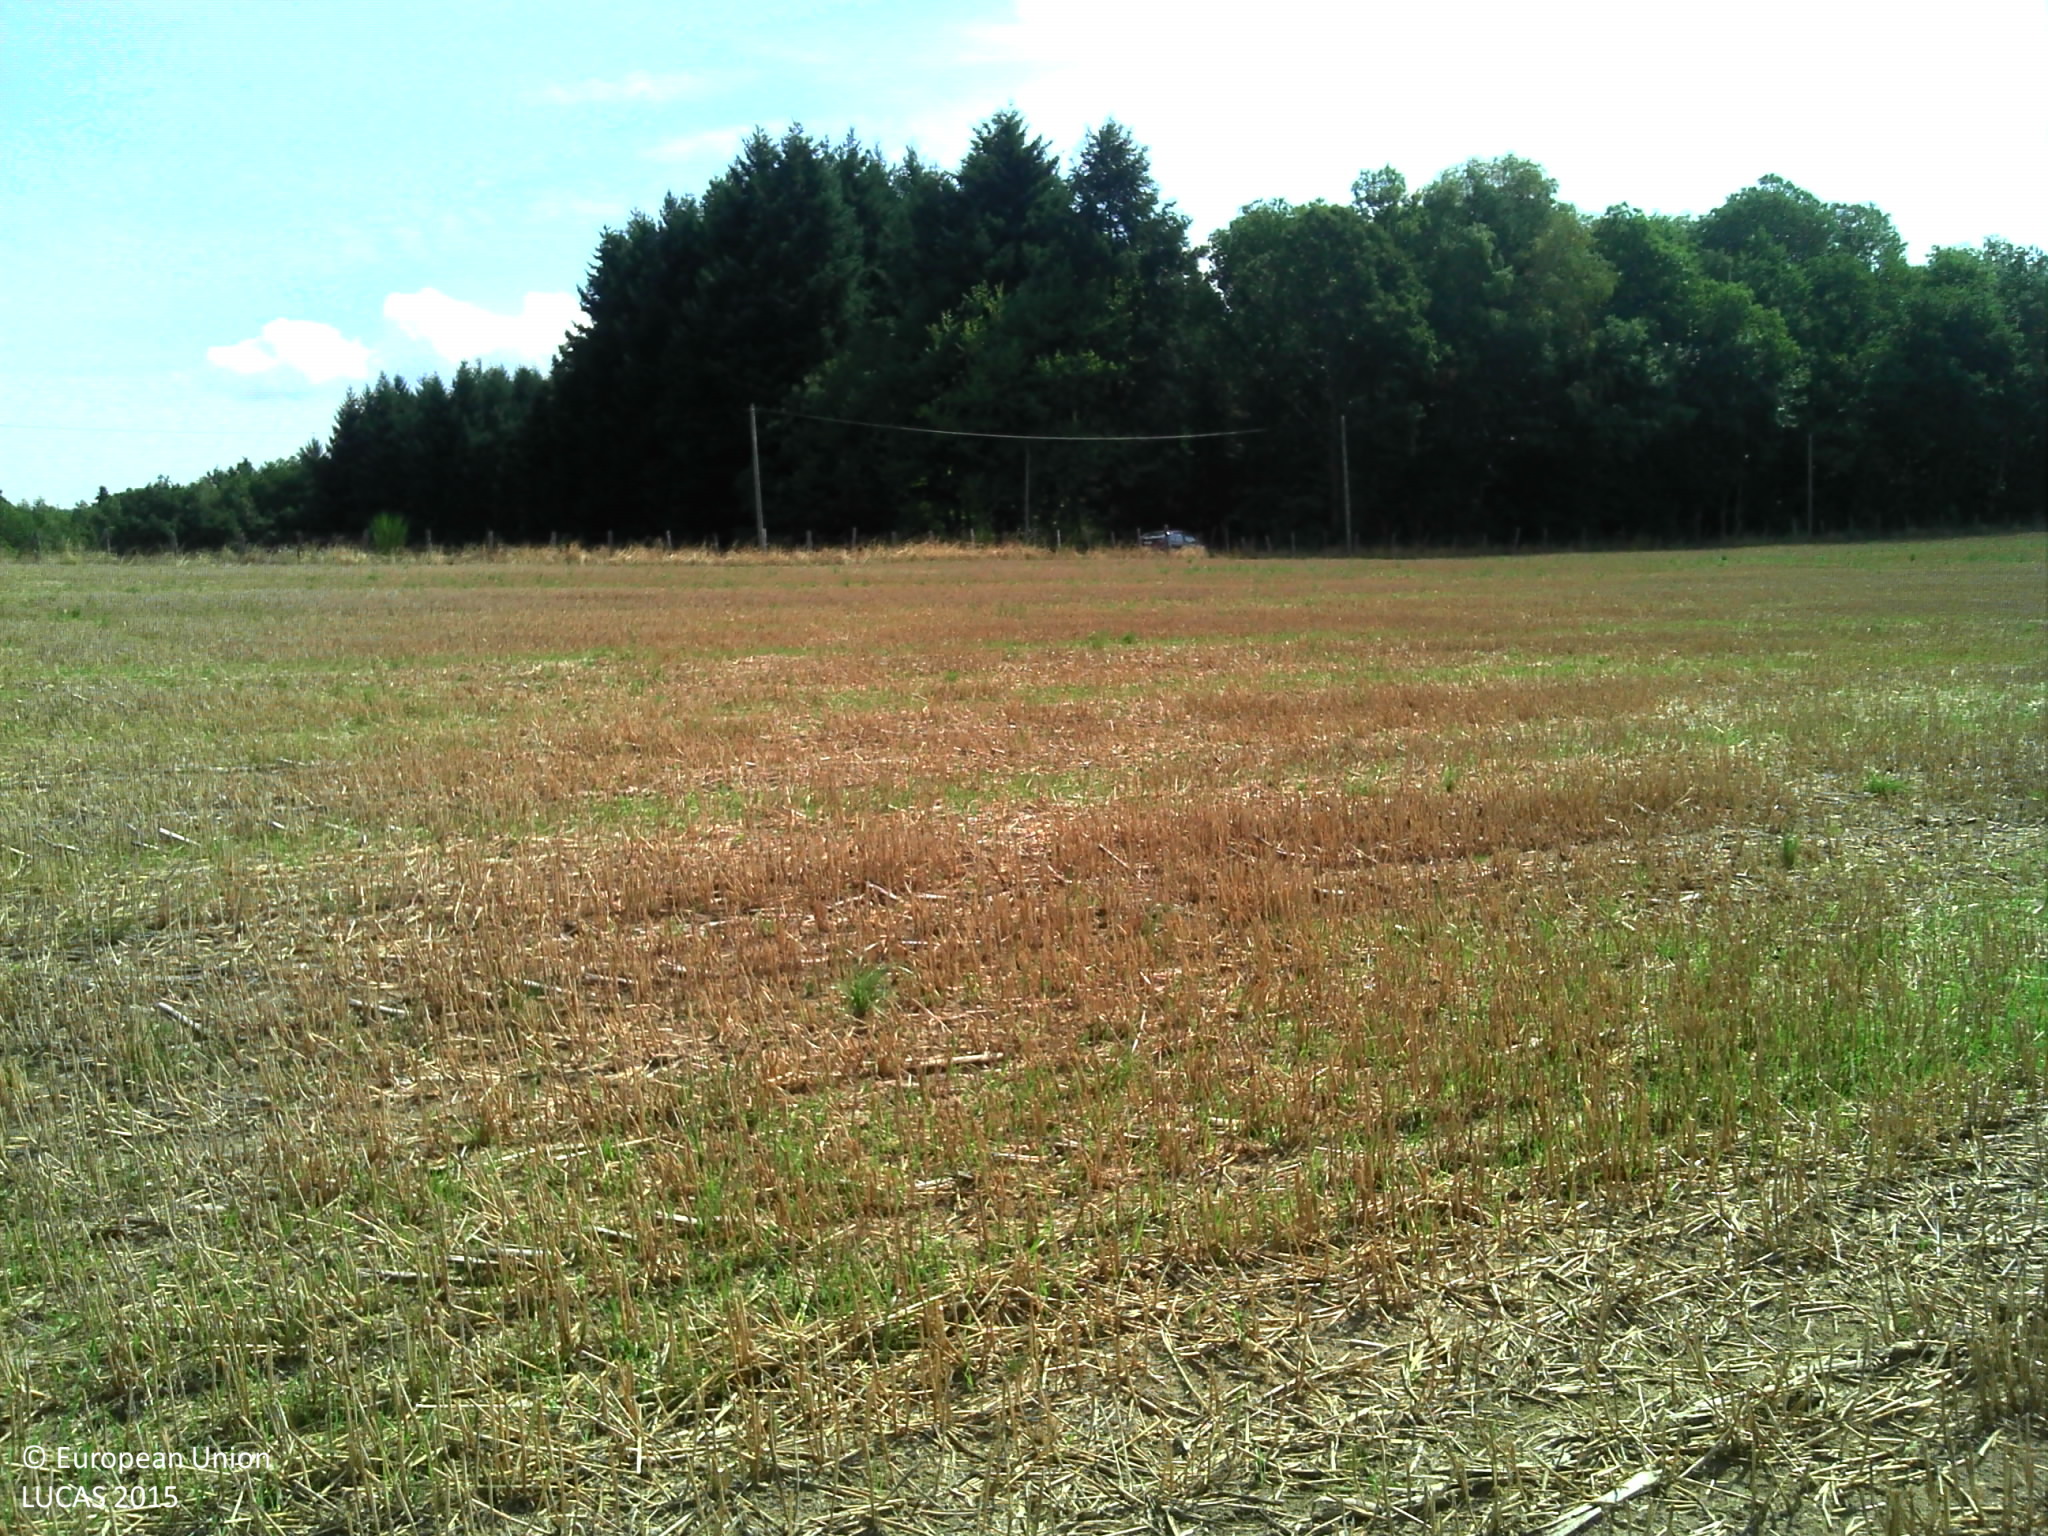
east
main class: Cropland
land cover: Common wheat
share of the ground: 50 - 75 %
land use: Agriculture (excluding fallow land and kitchen gardens)
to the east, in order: Common wheat; Fences; Paved roads, cycling and walking lanes; Broadleaved woodland; Spruce dominated mixed woodland; Paved roads, cycling and walking lanes; Spruce dominated coniferous woodland
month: August
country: FR
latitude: 46.1927
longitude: 4.5211
